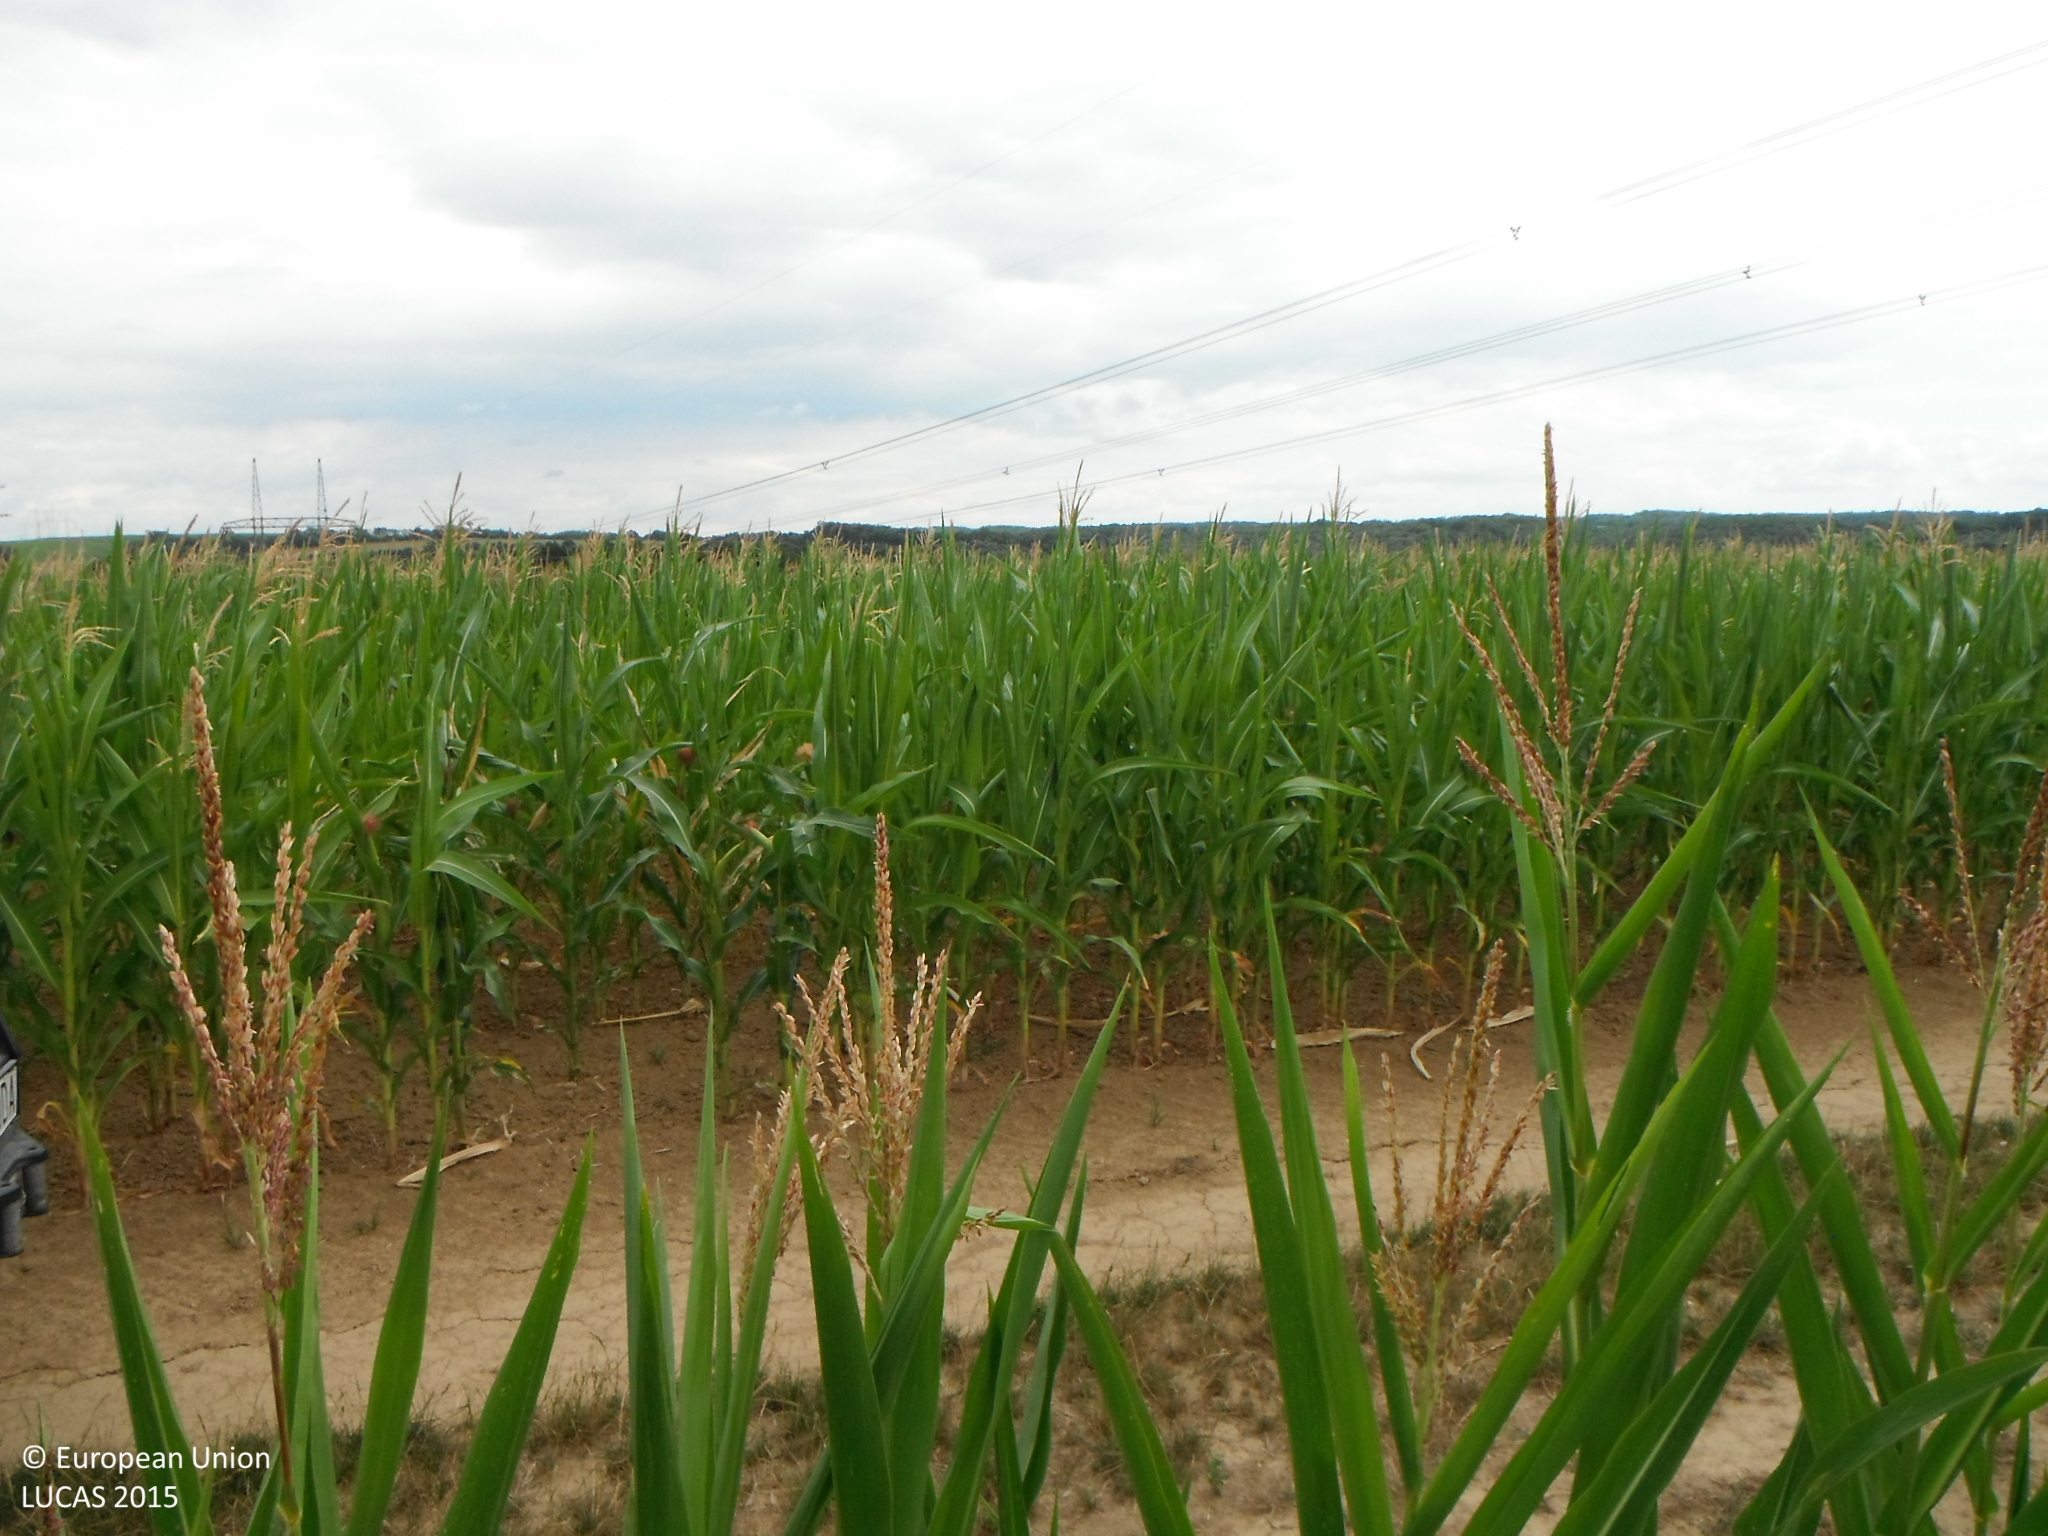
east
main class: Cropland
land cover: Maize
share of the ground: > 75 %
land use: Agriculture (excluding fallow land and kitchen gardens)
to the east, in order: Maize; Electric lines; Maize
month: July
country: SK
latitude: 48.2728
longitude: 18.9798
